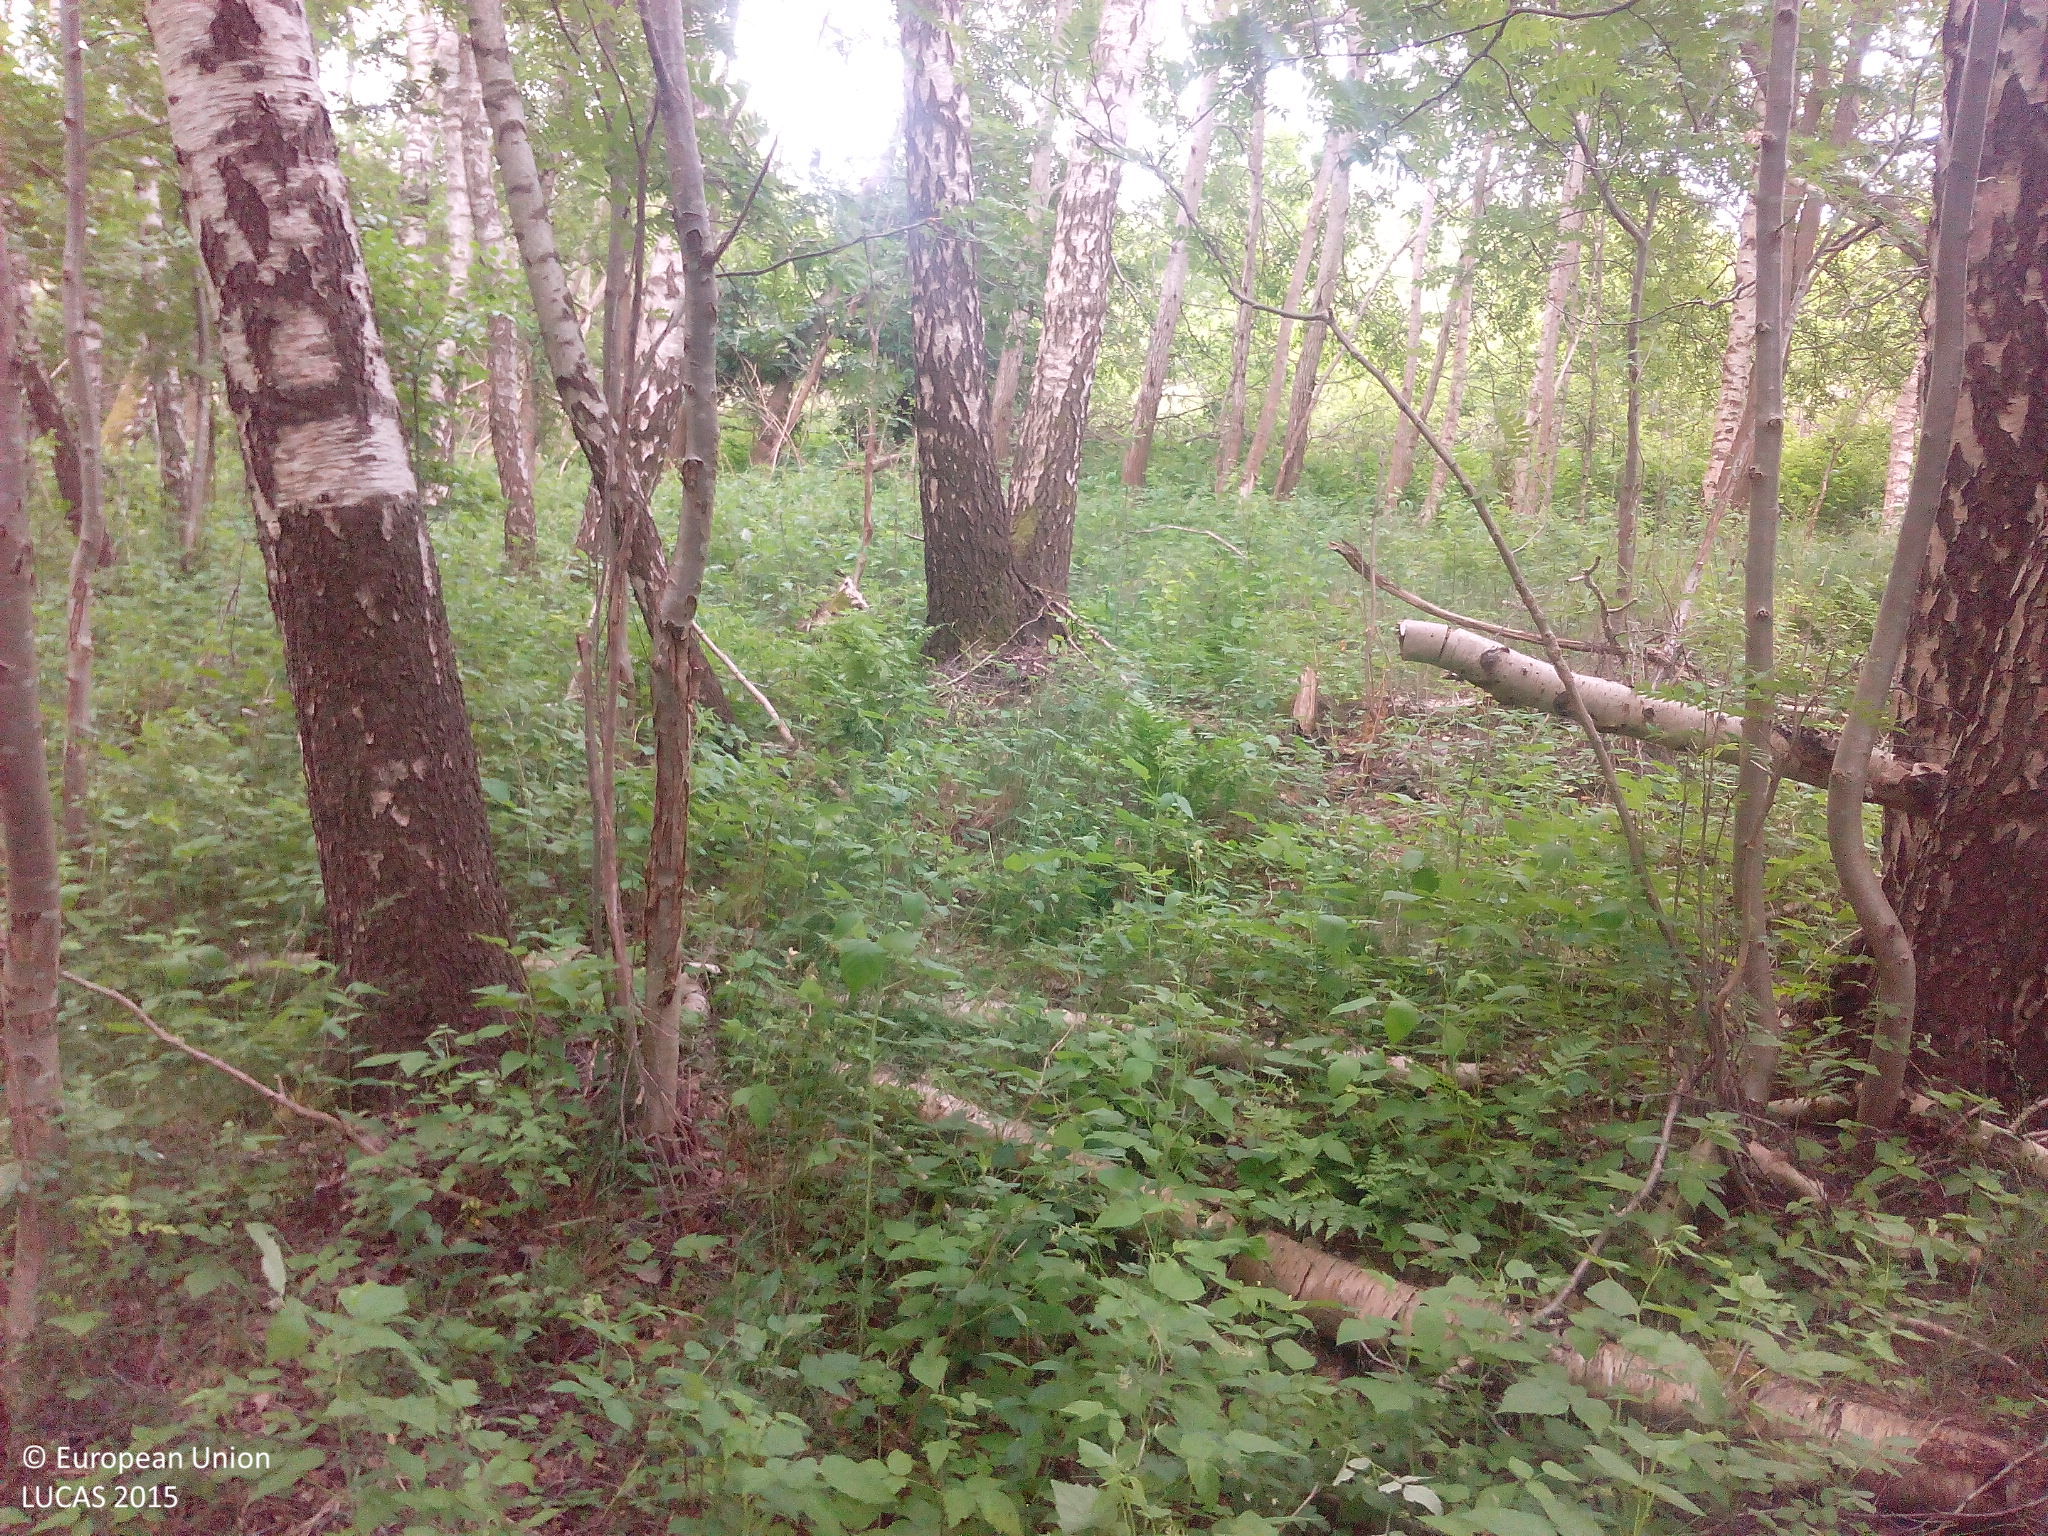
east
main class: Woodland
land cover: Broadleaved woodland
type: non-riverine alder, birch or aspen forest
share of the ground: > 75 %
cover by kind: broadleaved forest trees 90 %, coniferous forest trees 5 %, herbaceous plants 5 %
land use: Forestry
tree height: > 5 m
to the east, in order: Broadleaved woodland; Ditches and canals; Broadleaved woodland; Grassland without tree/shrub cover; Artificial constructions in urban areas; Pine dominated mixed woodland; Other mixed woodland; Broadleaved woodland
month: June
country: DE
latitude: 53.9732
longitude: 13.7655
